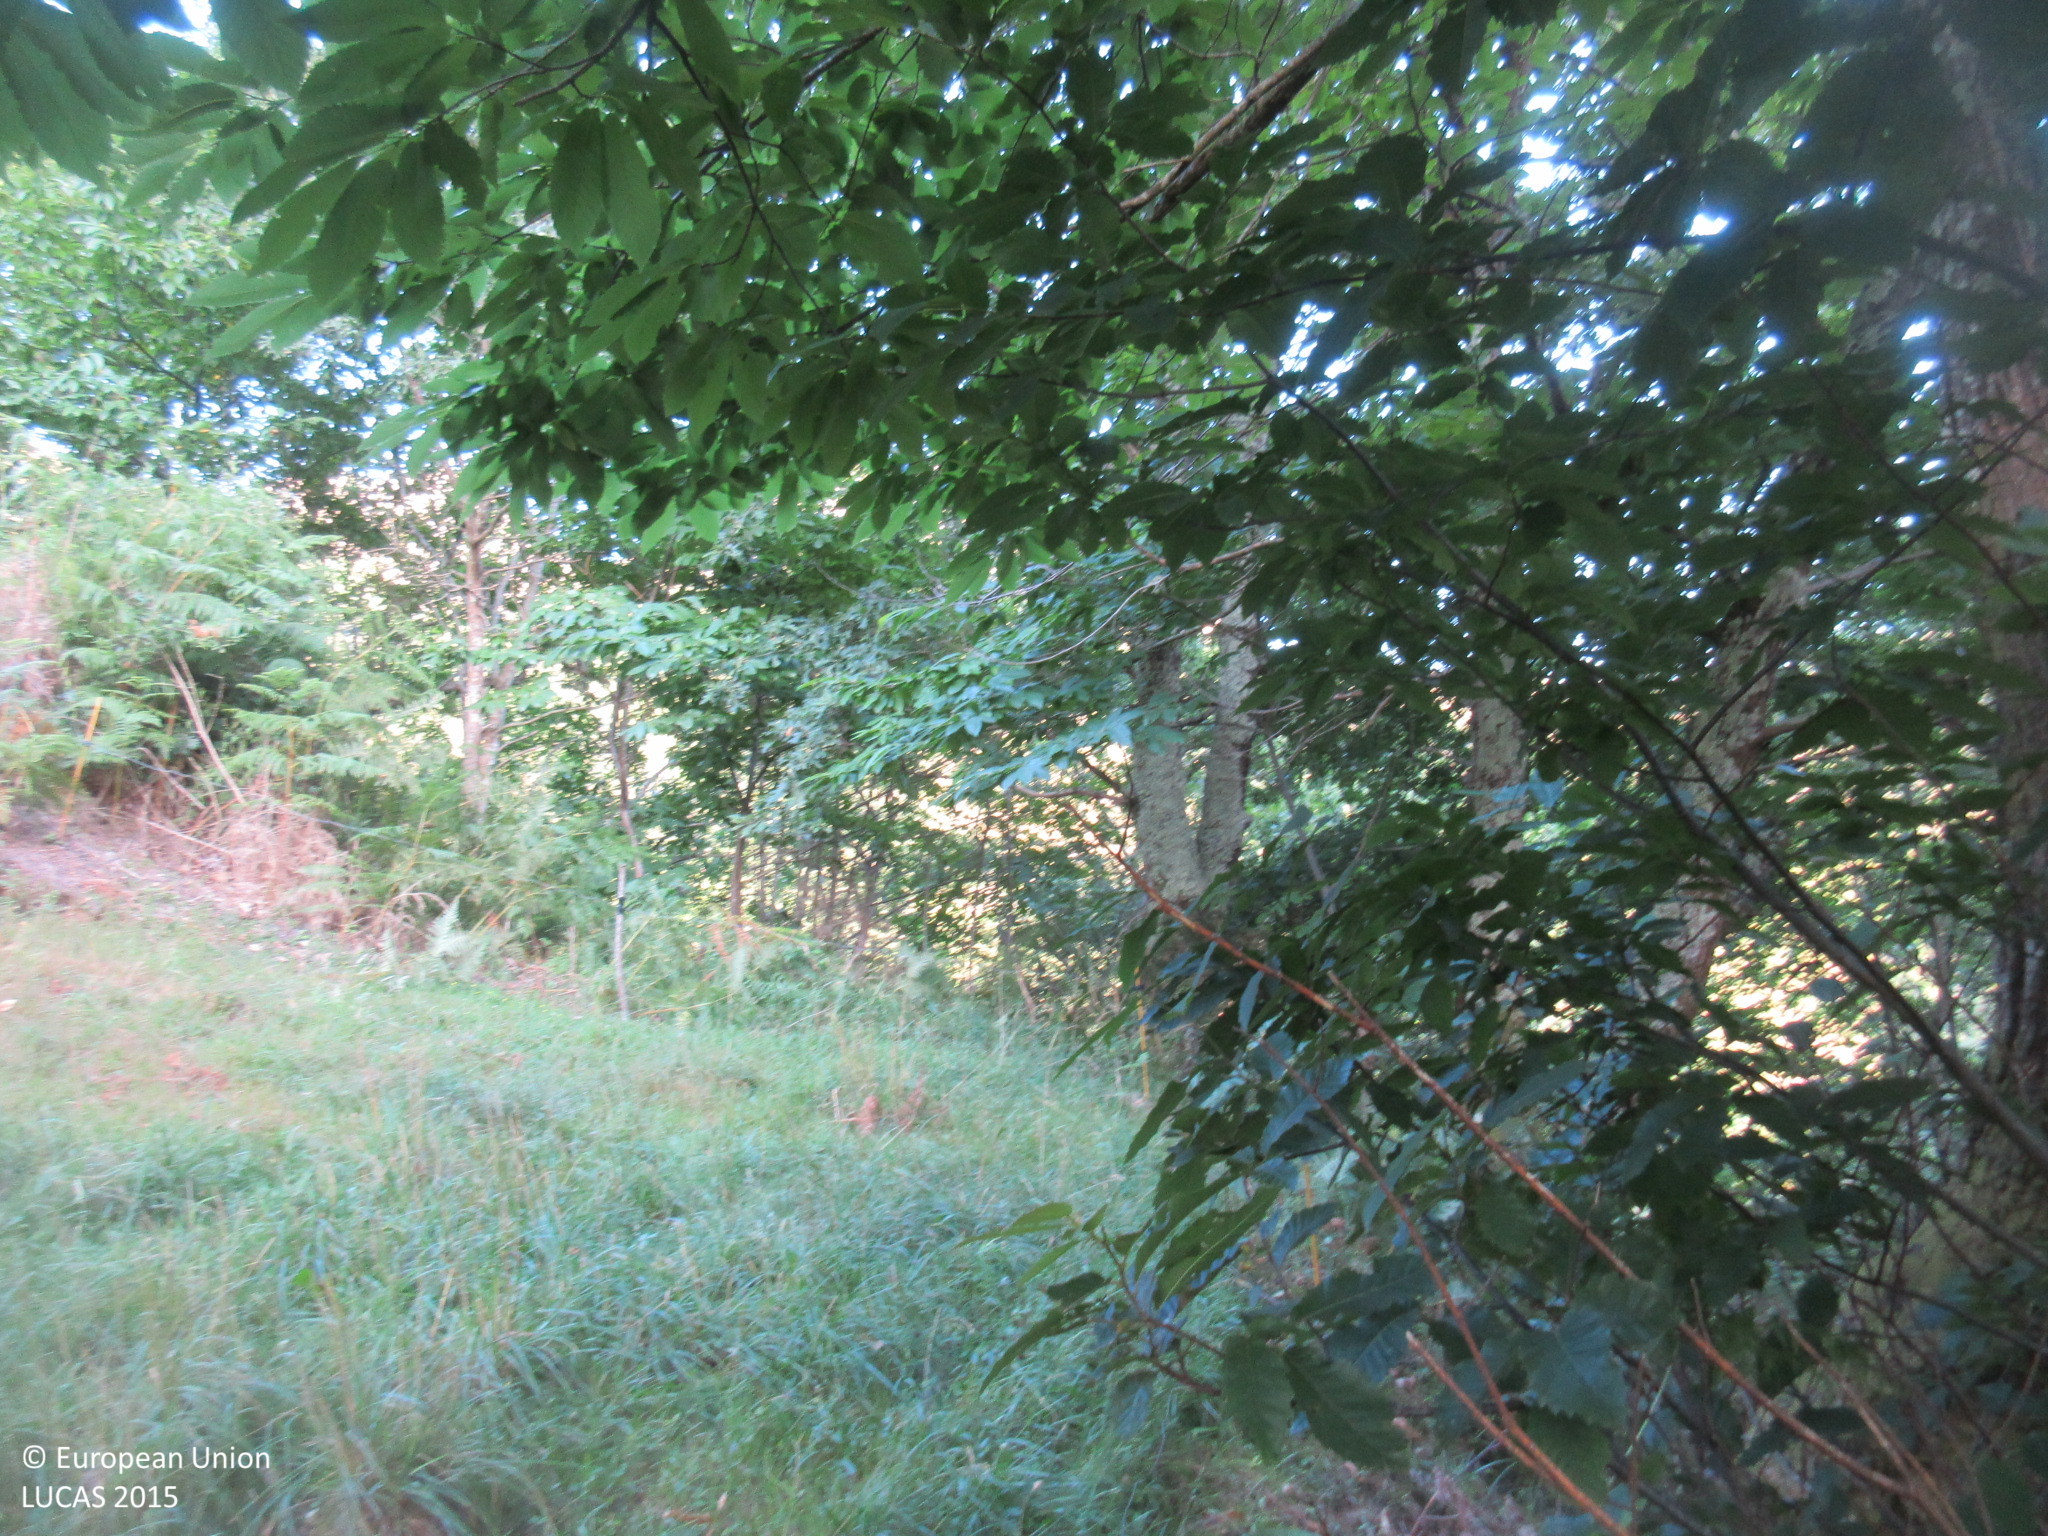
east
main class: Woodland
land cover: Broadleaved woodland
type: thermophilous deciduous forest
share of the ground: > 75 %
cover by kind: broadleaved forest trees 95 %, shrubs 5 %
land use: Forestry
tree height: > 5 m
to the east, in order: Broadleaved woodland; Grassland with sparse tree/shrub cover
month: July
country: ES
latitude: 43.3926
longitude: -5.0462
